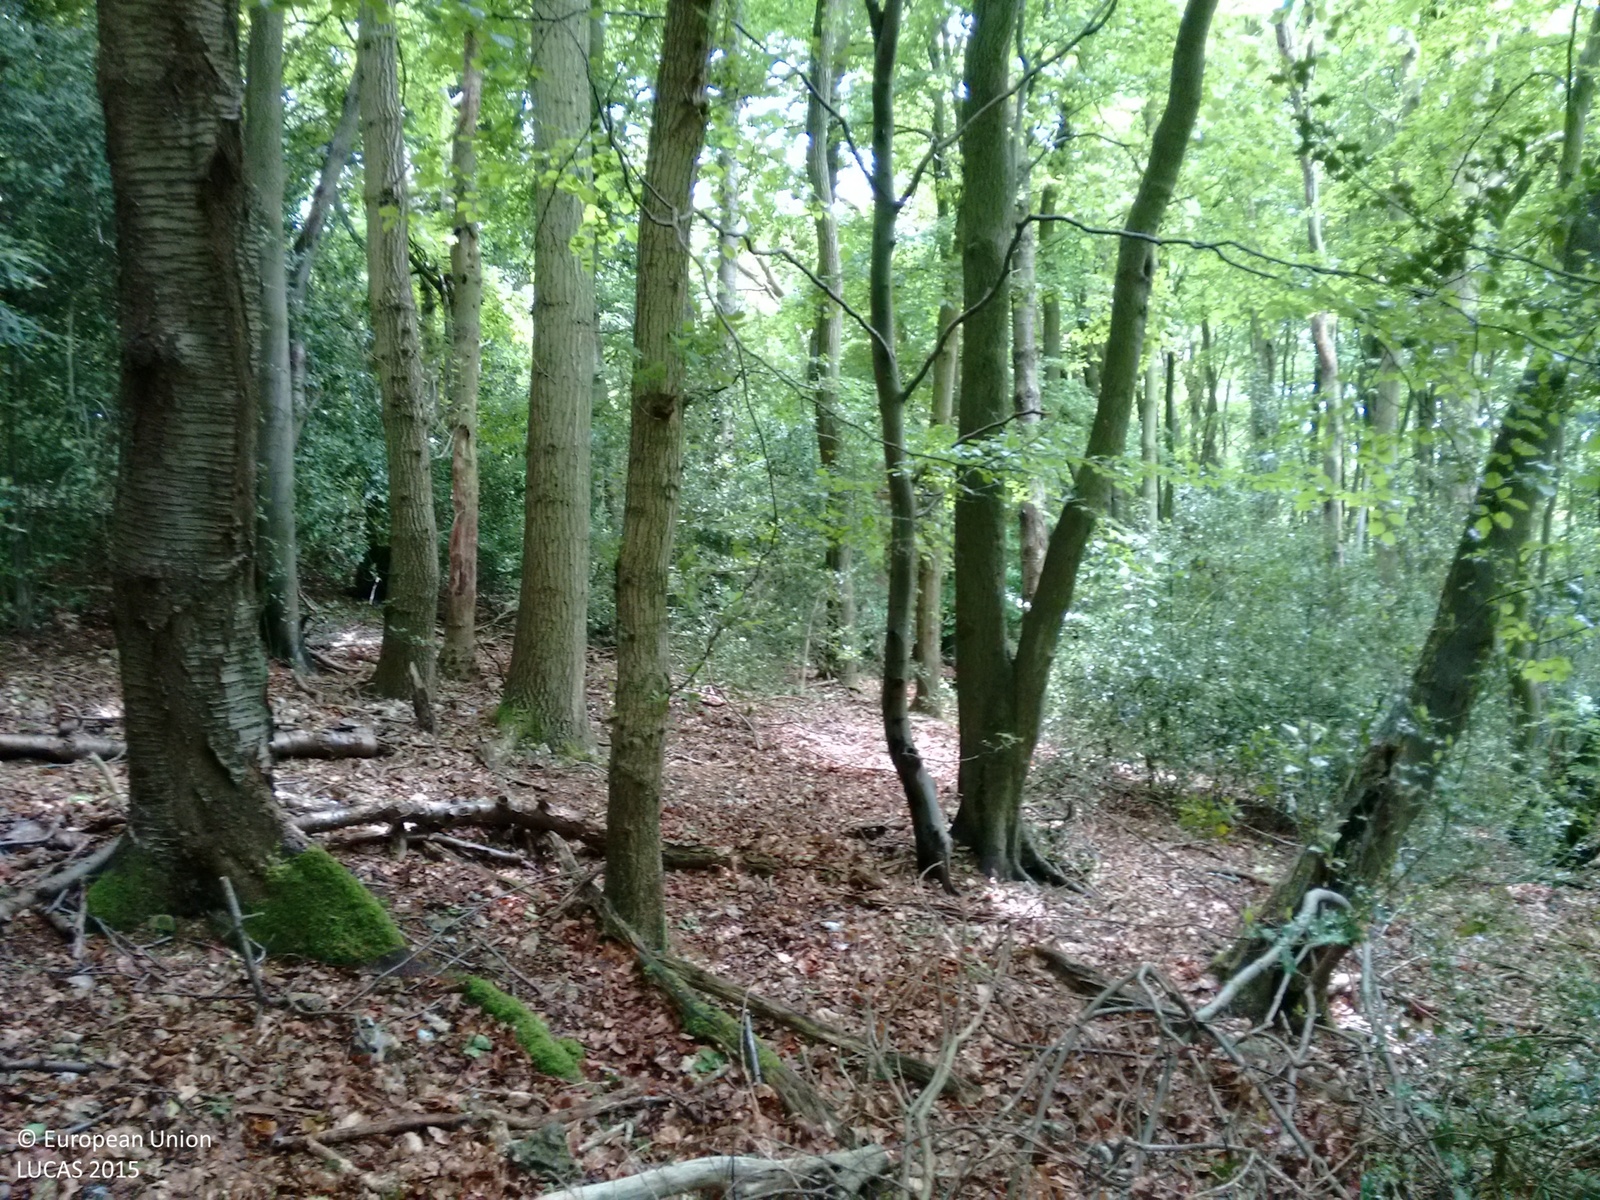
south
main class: Woodland
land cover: Broadleaved woodland
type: mesophytic deciduous forest
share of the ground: > 75 %
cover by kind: broadleaved forest trees 95 %, shrubs 5 %
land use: Semi-natural and natural areas not in use
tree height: > 5 m
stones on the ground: 25 - 50 %
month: June
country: GB
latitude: 51.6873
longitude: -0.7601
